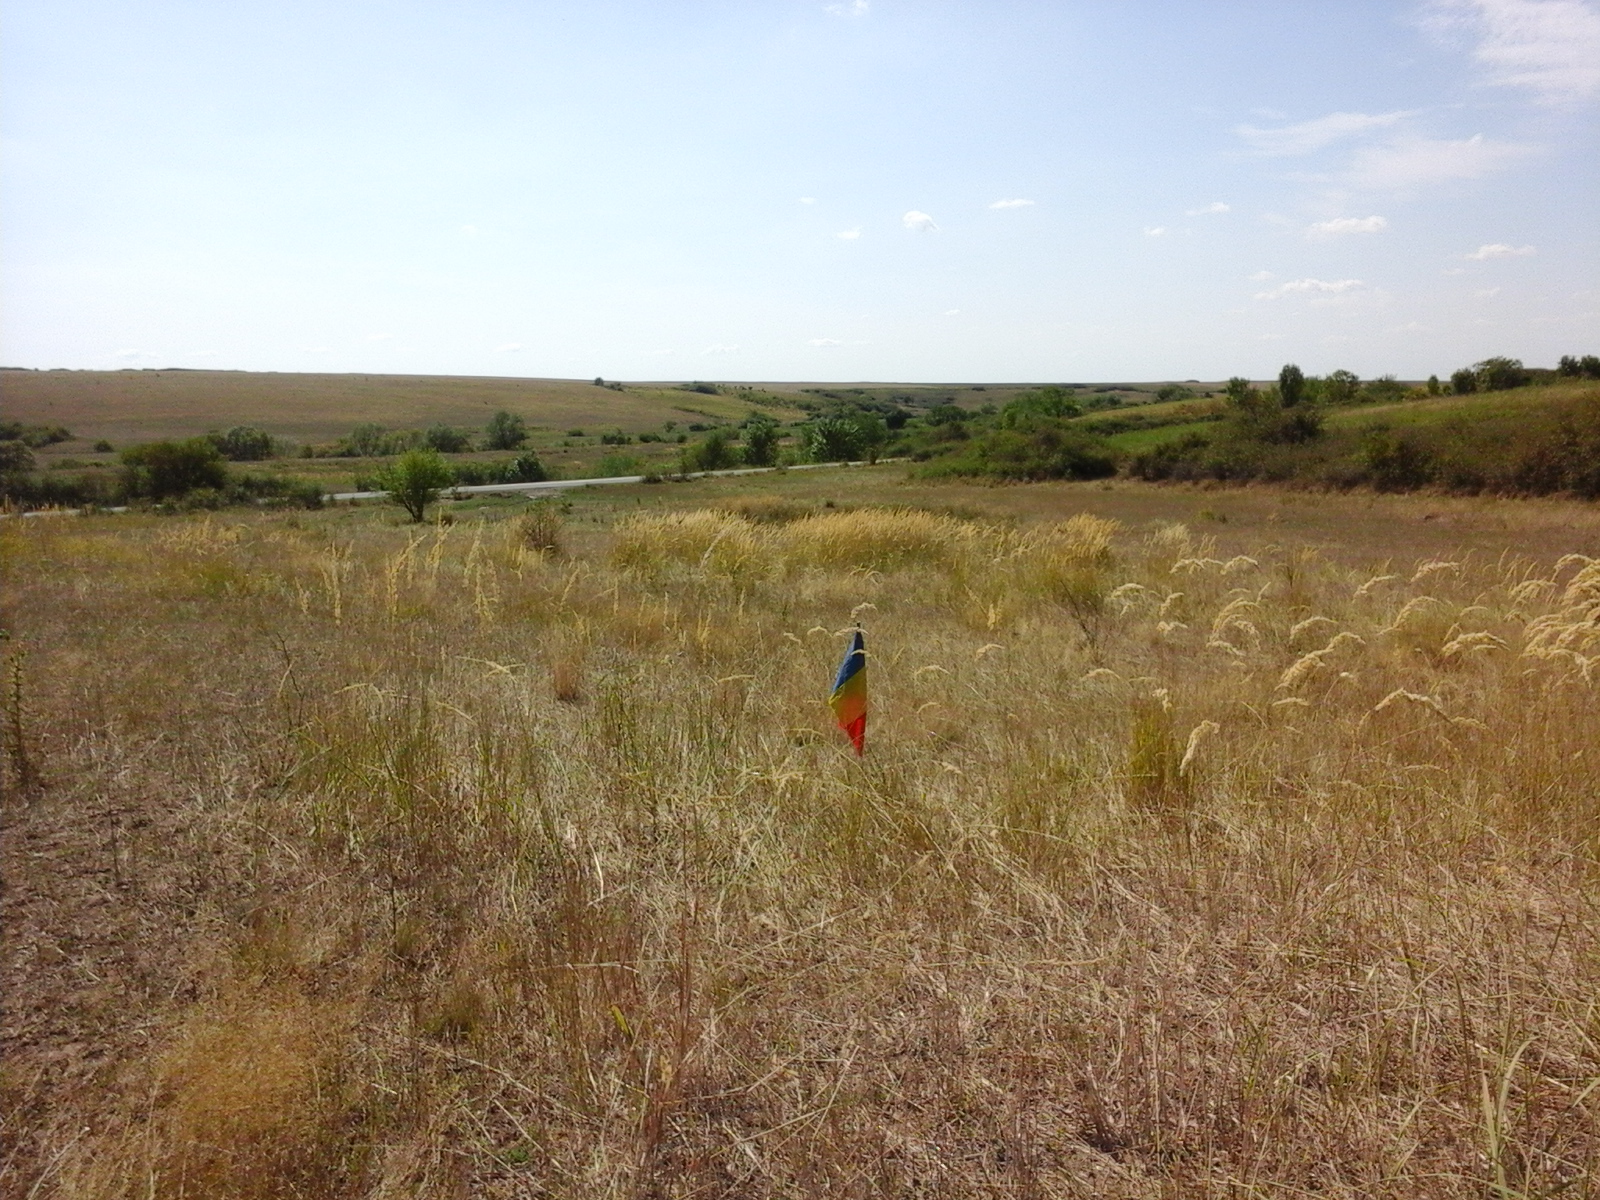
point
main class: Grassland
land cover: Grassland without tree/shrub cover
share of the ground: > 75 %
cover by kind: herbaceous plants 100 %
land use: Agriculture (excluding fallow land and kitchen gardens)
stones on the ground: < 10 %
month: August
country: RO
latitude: 45.2422
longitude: 21.4577
